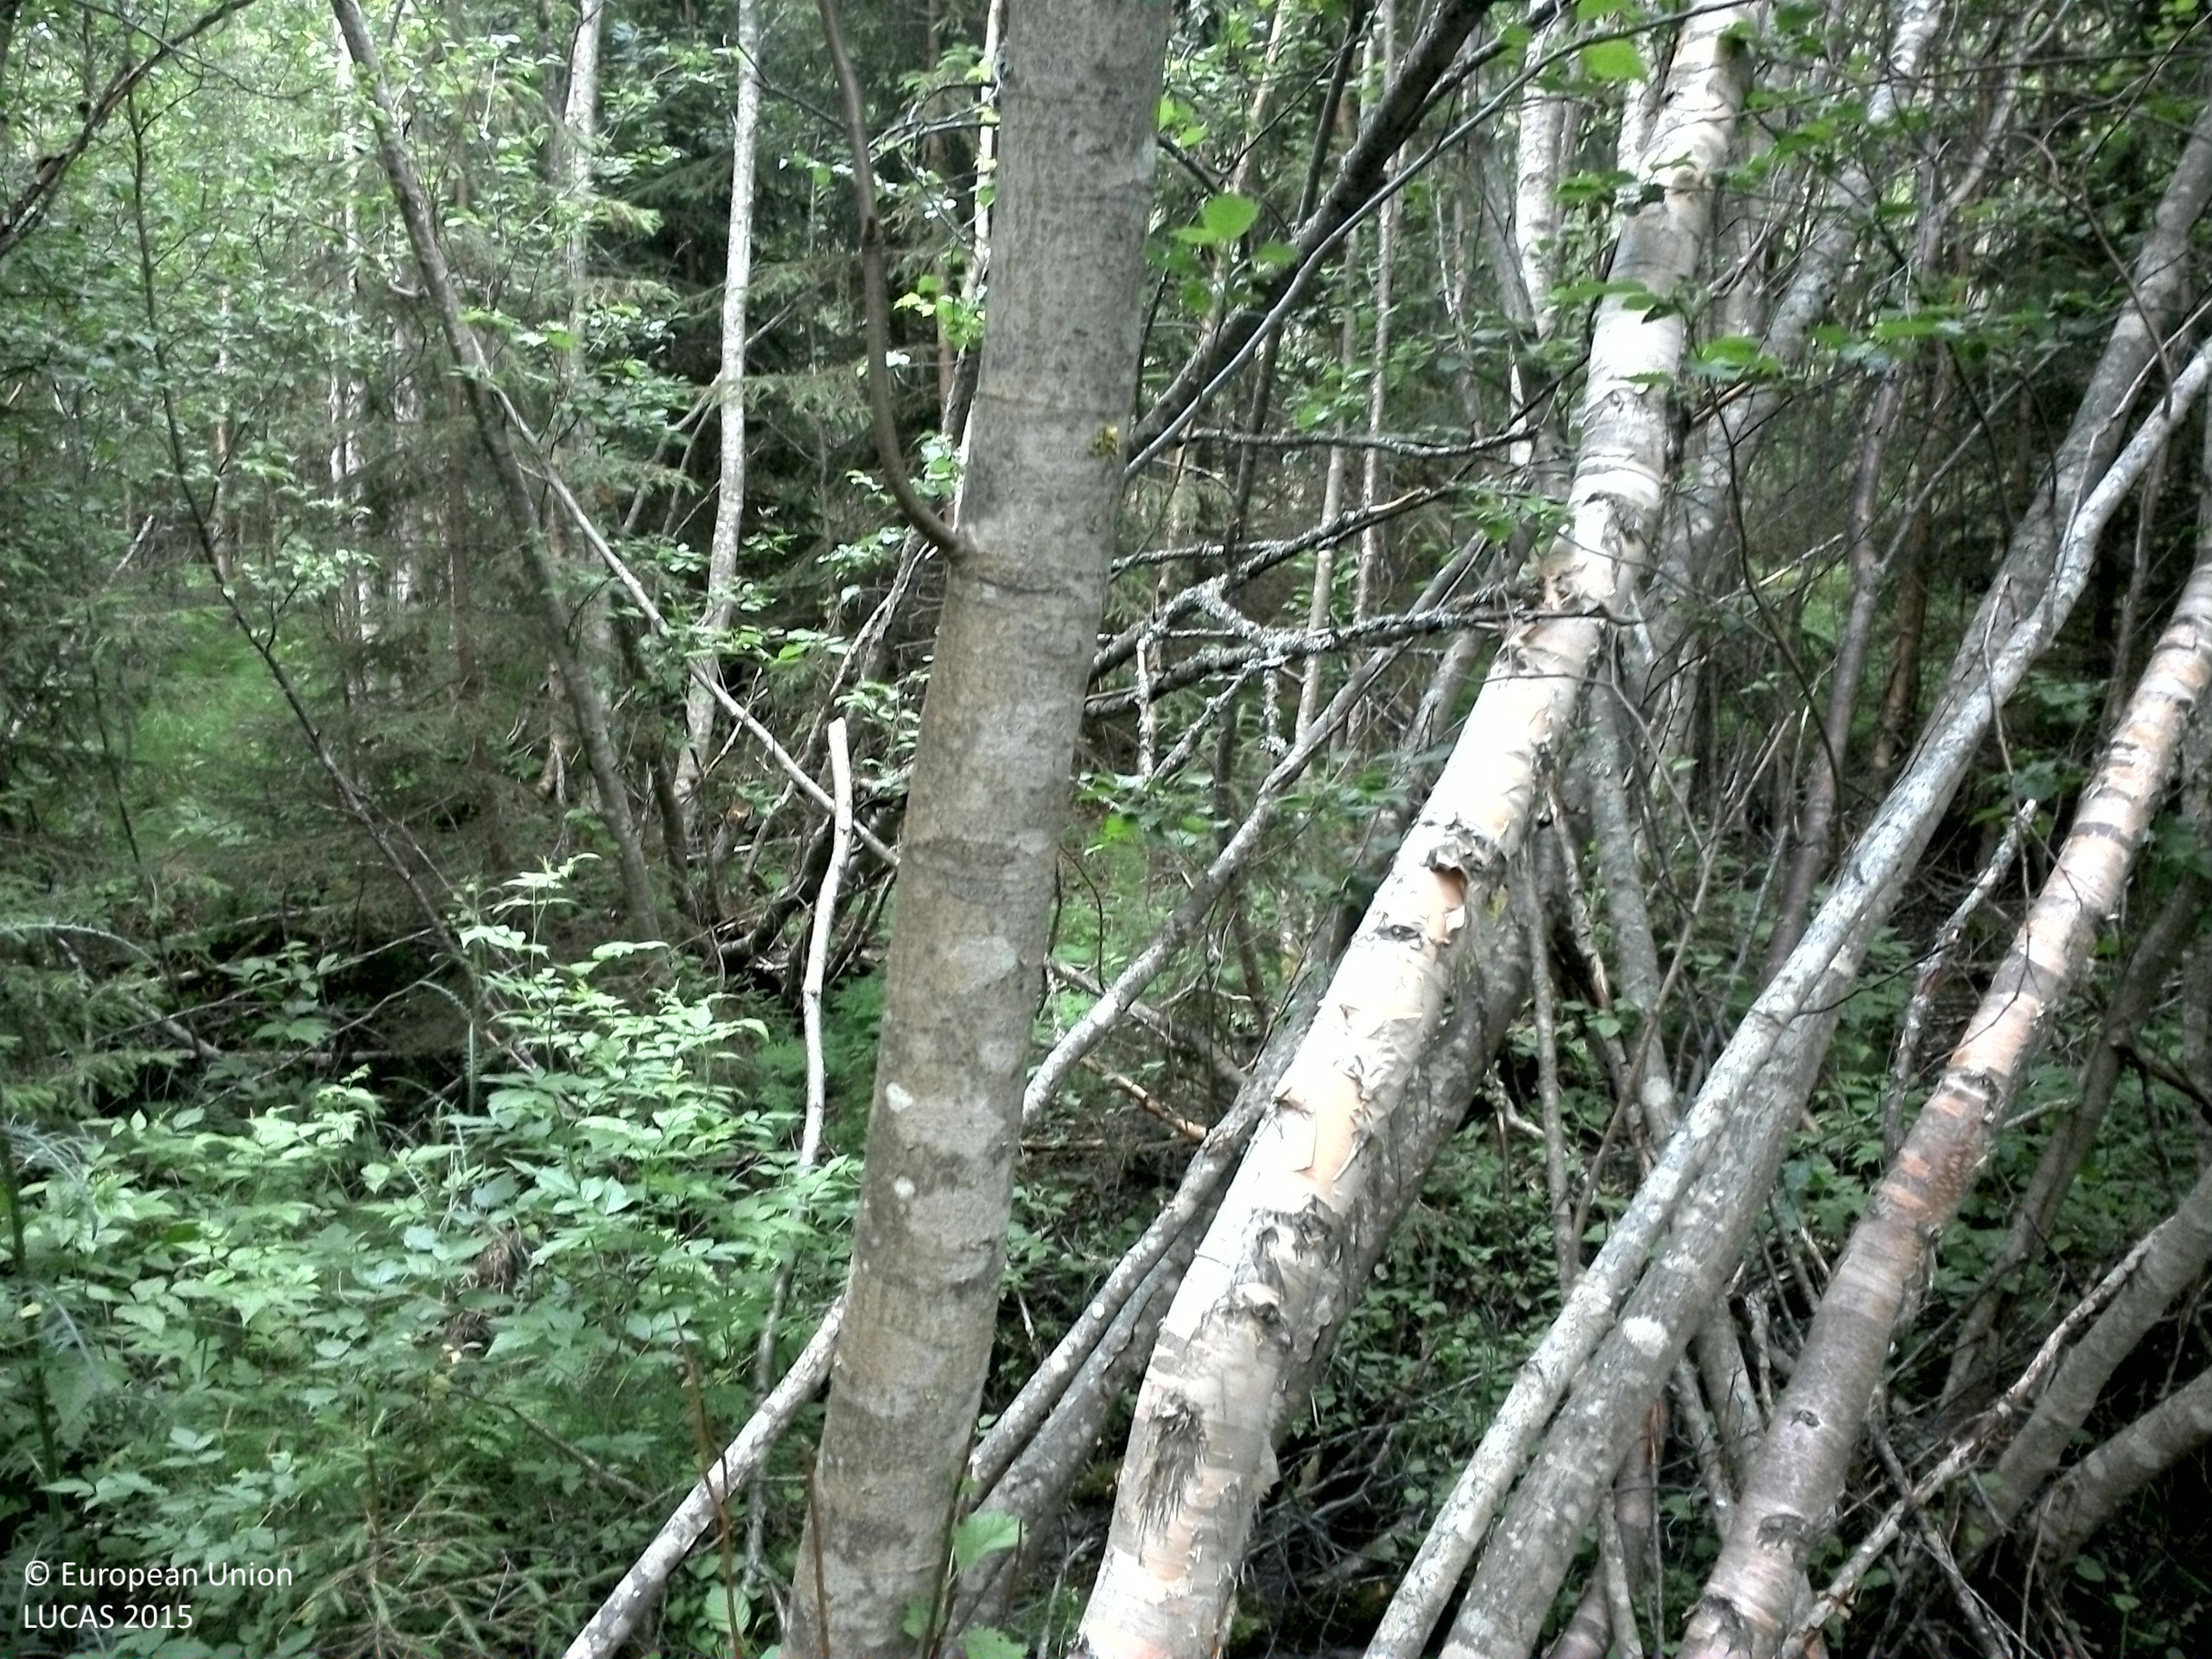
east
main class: Woodland
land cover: Spruce dominated mixed woodland
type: boreal forest
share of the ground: > 75 %
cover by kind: broadleaved forest trees 45 %, coniferous forest trees 40 %, herbaceous plants 10 %
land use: Forestry
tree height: > 5 m
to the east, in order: Spruce dominated mixed woodland; Rivers and streams; Spruce dominated mixed woodland; Paved roads, cycling and walking lanes; Spruce dominated mixed woodland; Pine dominated coniferous woodland; Rocks and stones; Pine dominated coniferous woodland; Pine dominated mixed woodland; Spruce dominated mixed woodland
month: August
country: SE
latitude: 63.7141
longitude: 16.6717
